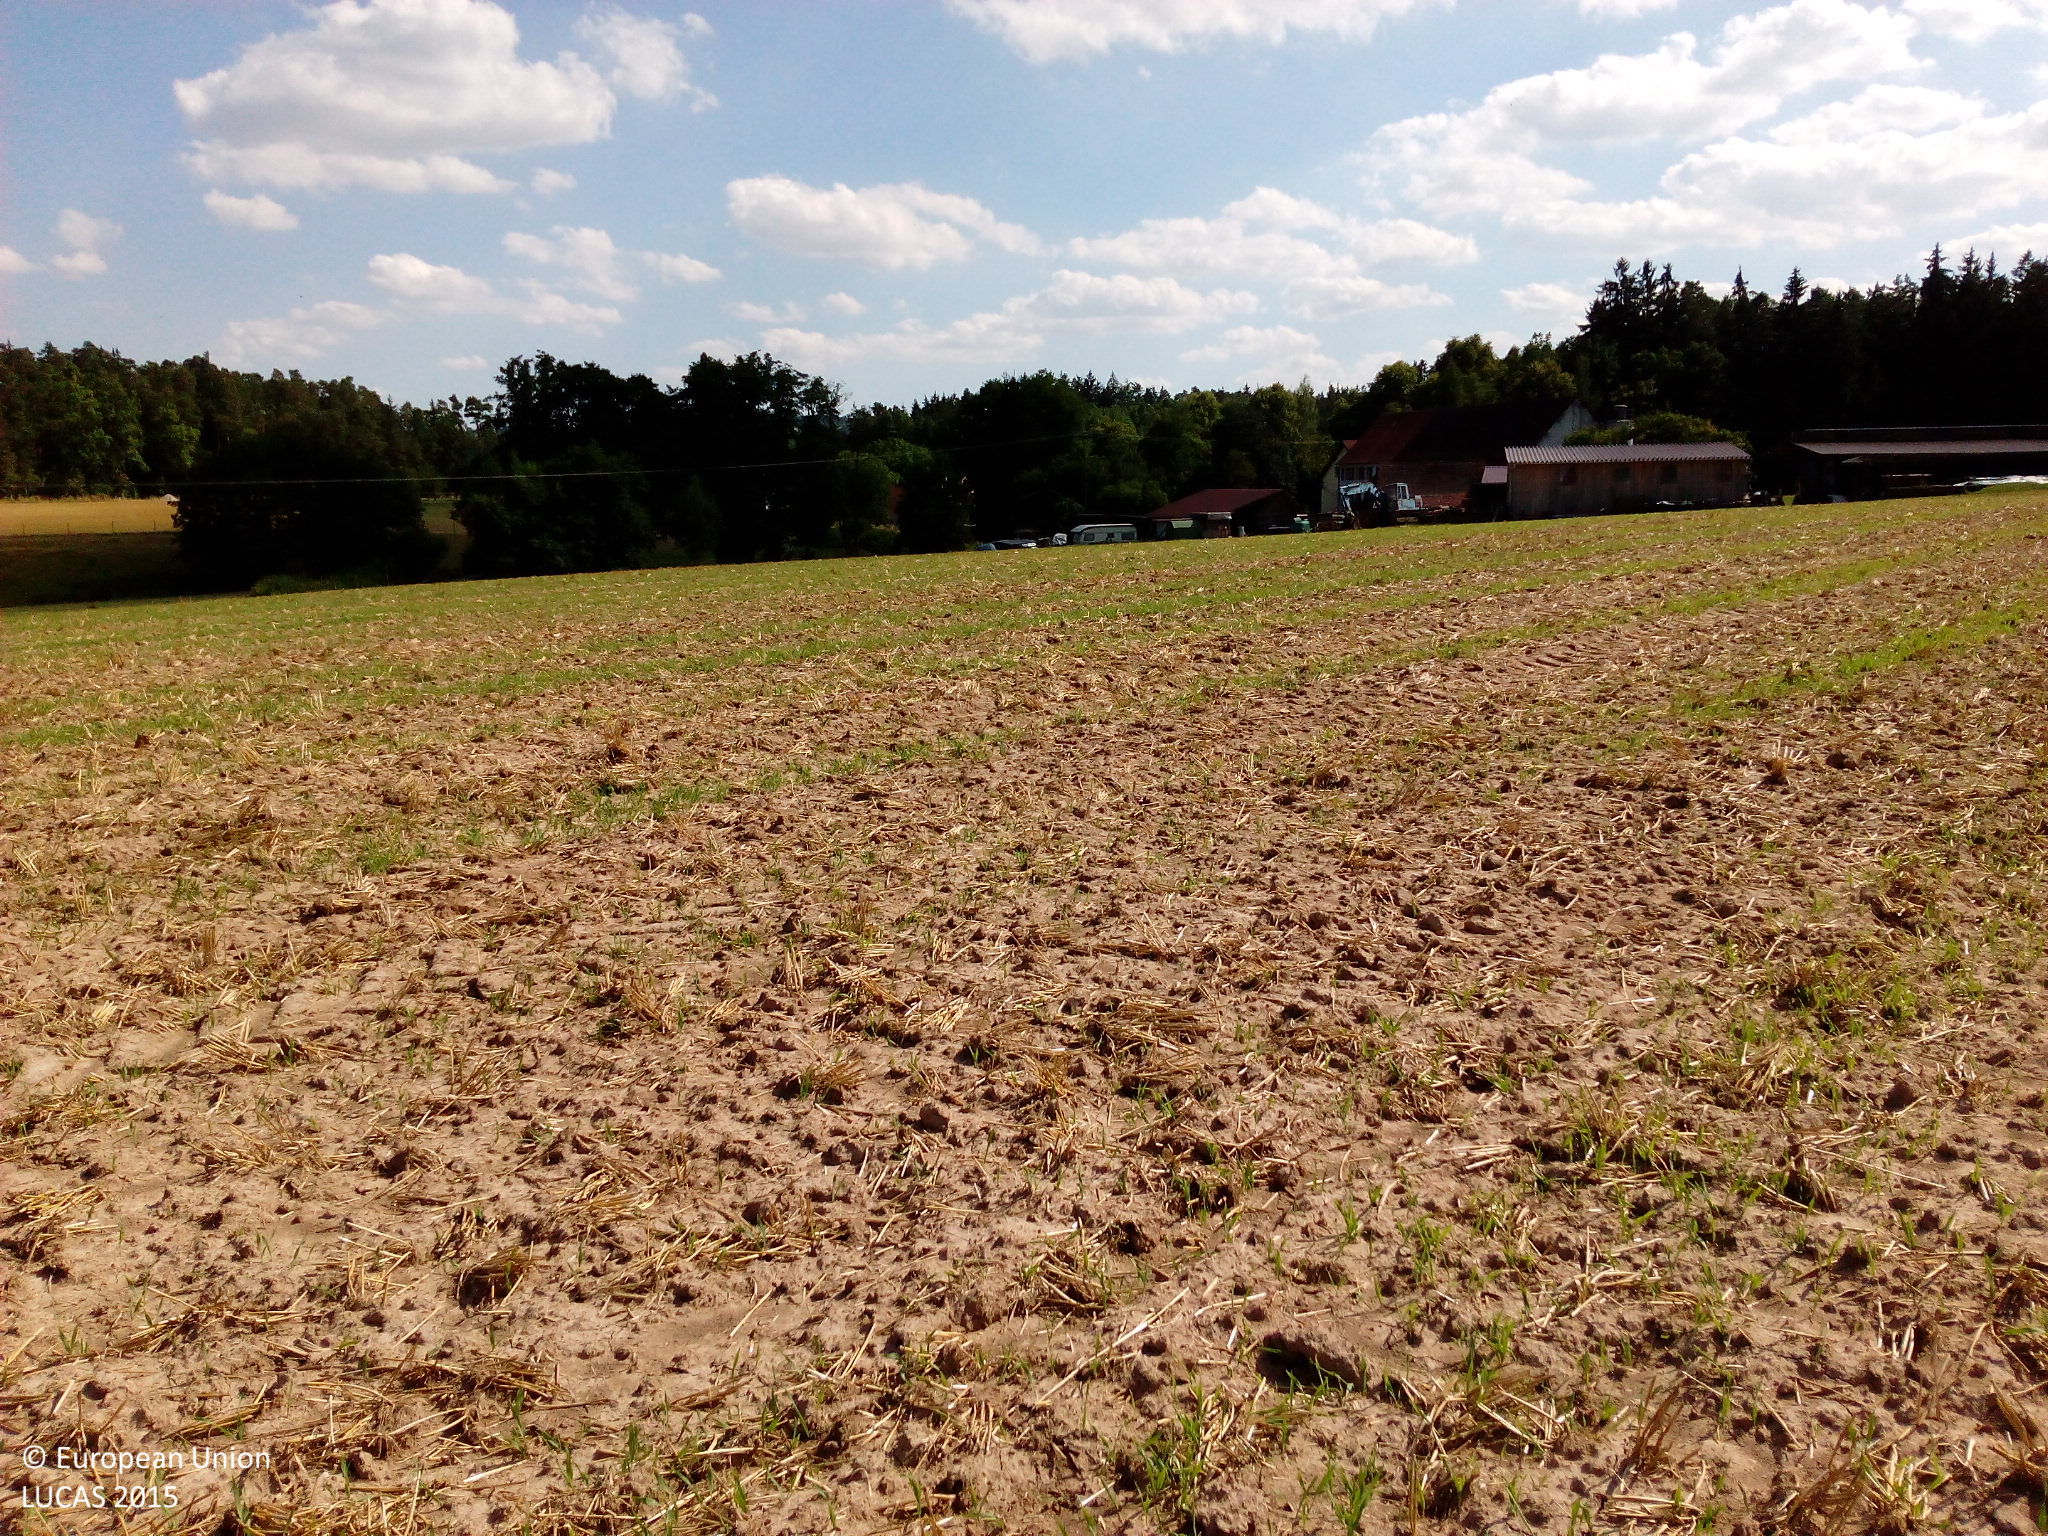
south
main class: Cropland
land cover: Common wheat
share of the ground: < 10 %
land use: Agriculture (excluding fallow land and kitchen gardens)
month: August
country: DE
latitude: 49.0147
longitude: 10.3143
